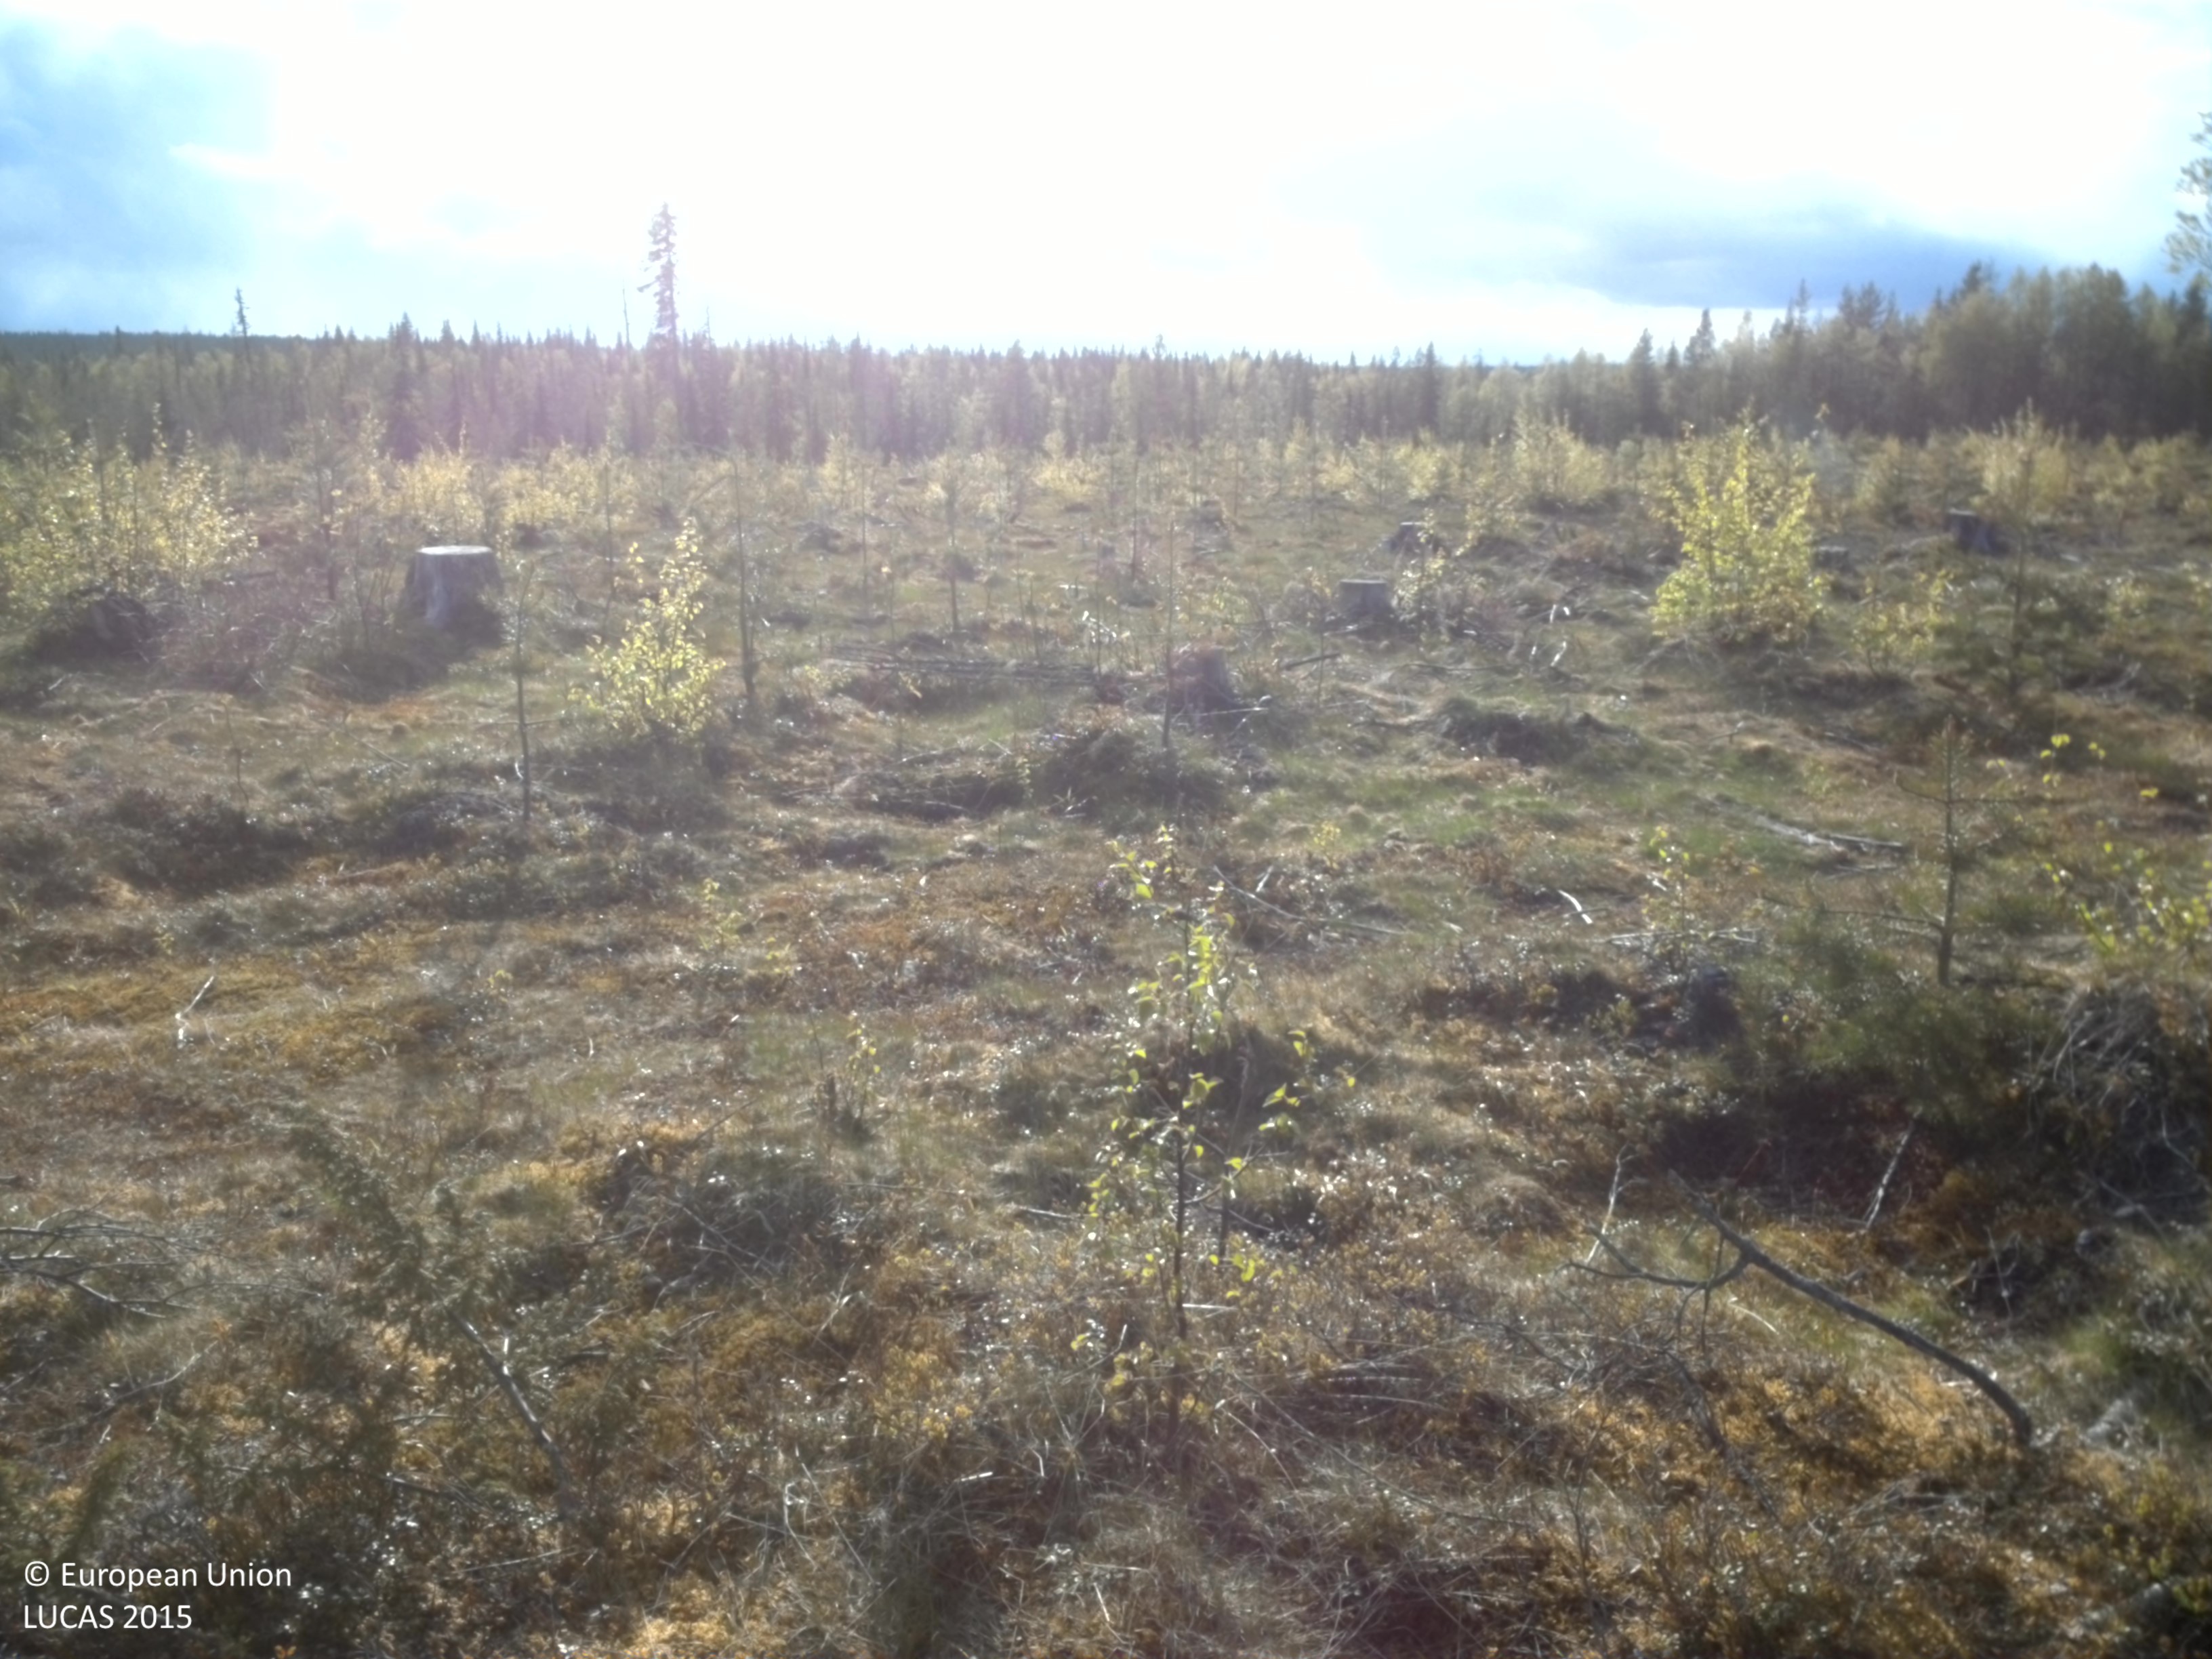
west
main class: Shrubland
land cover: Shrubland with sparse tree cover
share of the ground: 10 - 25 %
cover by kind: herbaceous plants 60 %, lichens and mosses 20 %, shrubs 15 %, broadleaved forest trees 5 %
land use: Forestry
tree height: < 5 m
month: June
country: SE
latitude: 66.8683
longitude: 22.3518
